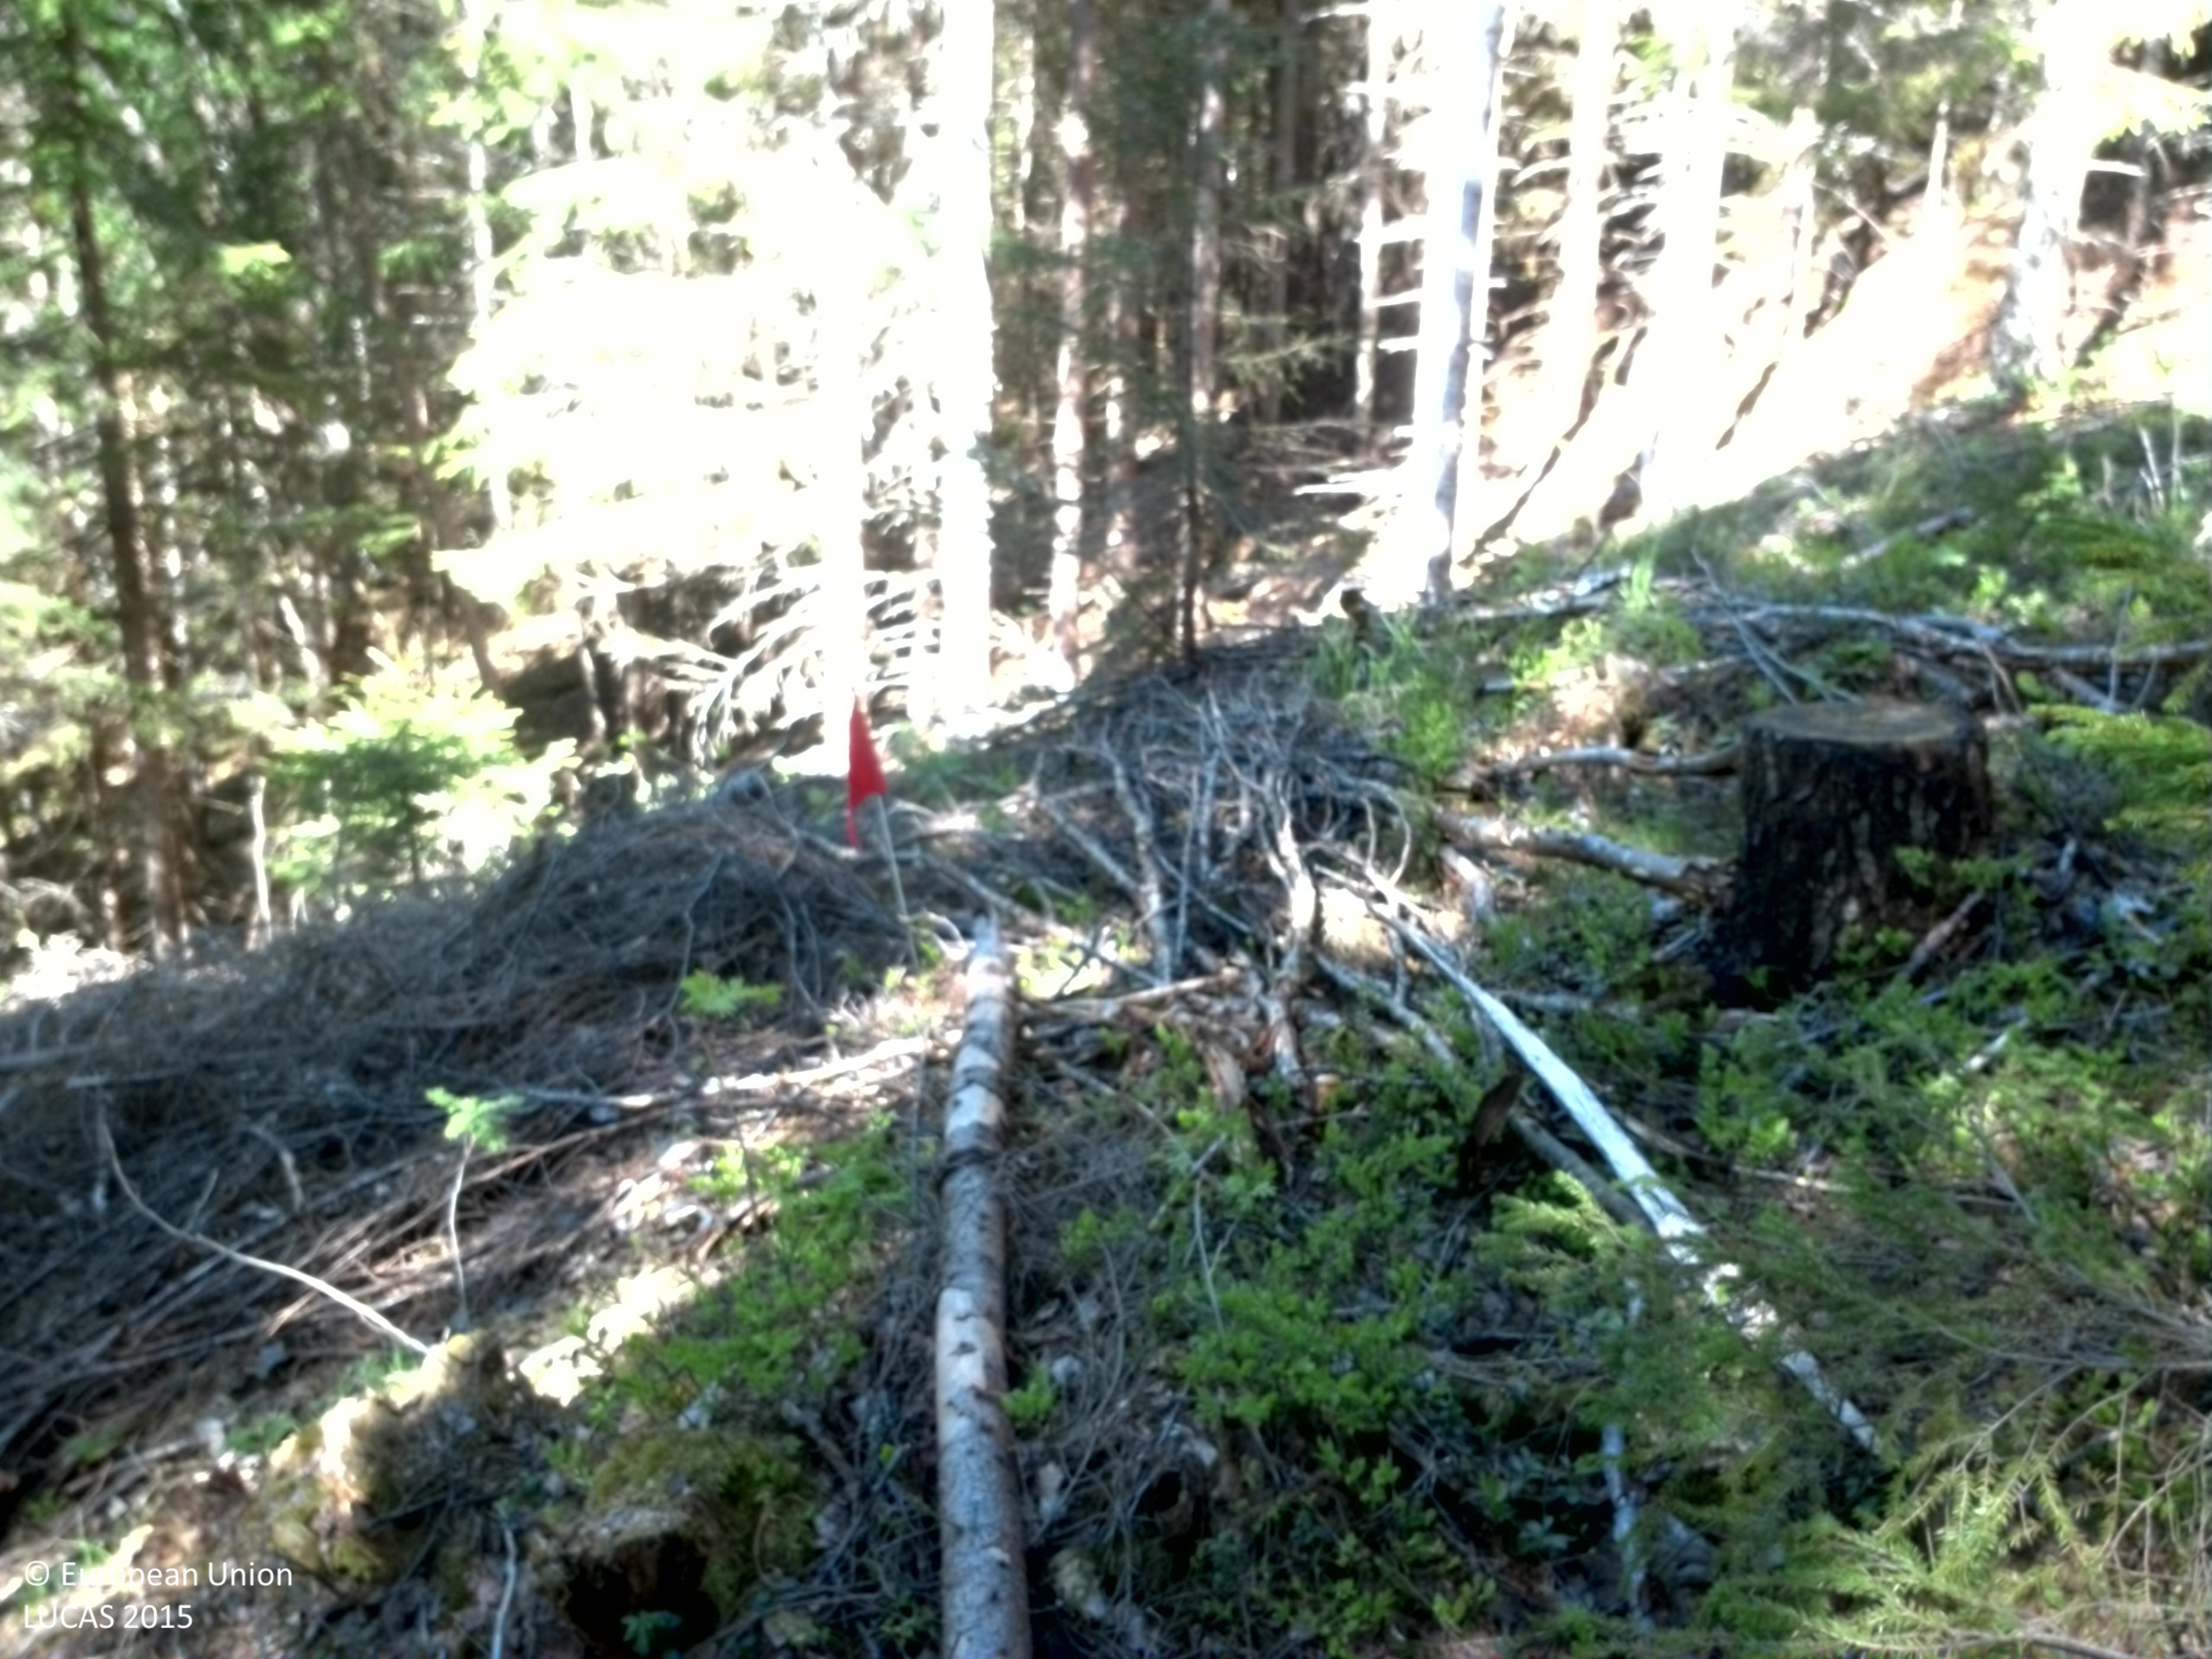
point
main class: Woodland
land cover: Spruce dominated coniferous woodland
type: boreal forest
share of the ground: 25 - 50 %
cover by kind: coniferous forest trees 50 %, shrubs 20 %, lichens and mosses 10 %
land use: Forestry
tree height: > 5 m
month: May
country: SE
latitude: 63.0015
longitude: 17.9351
